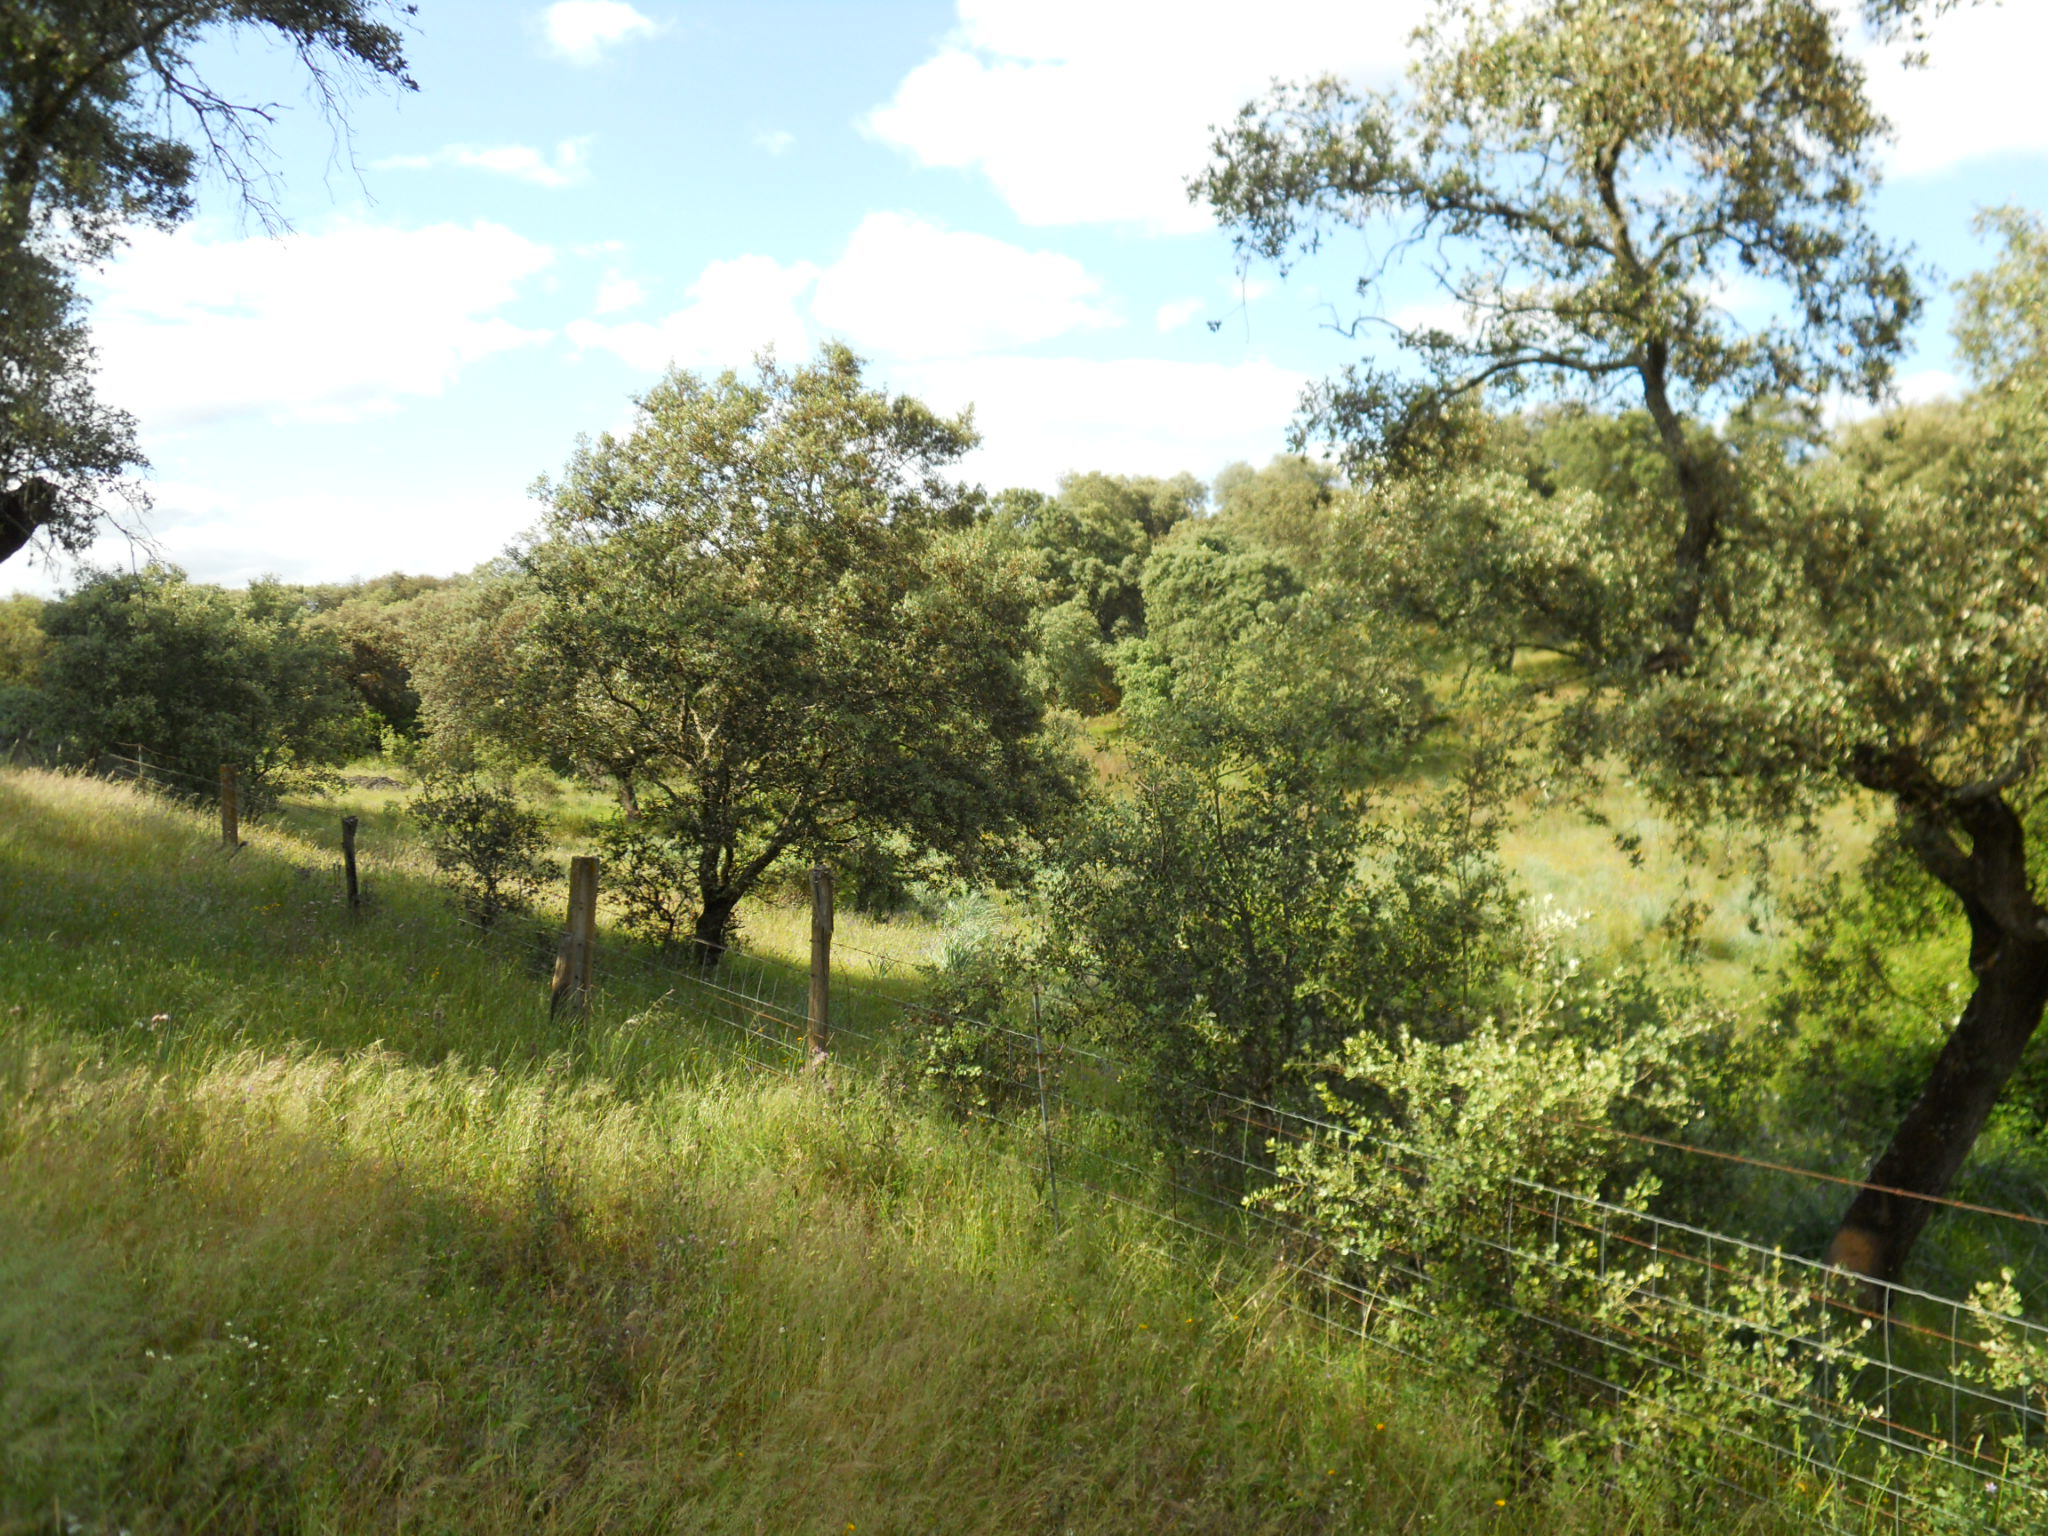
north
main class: Woodland
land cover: Broadleaved woodland
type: broadleaved evergreen forest
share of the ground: > 75 %
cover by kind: broadleaved forest trees 90 %, herbaceous plants 10 %
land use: Forestry
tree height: > 5 m
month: May
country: ES
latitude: 39.0816
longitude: -6.9152
